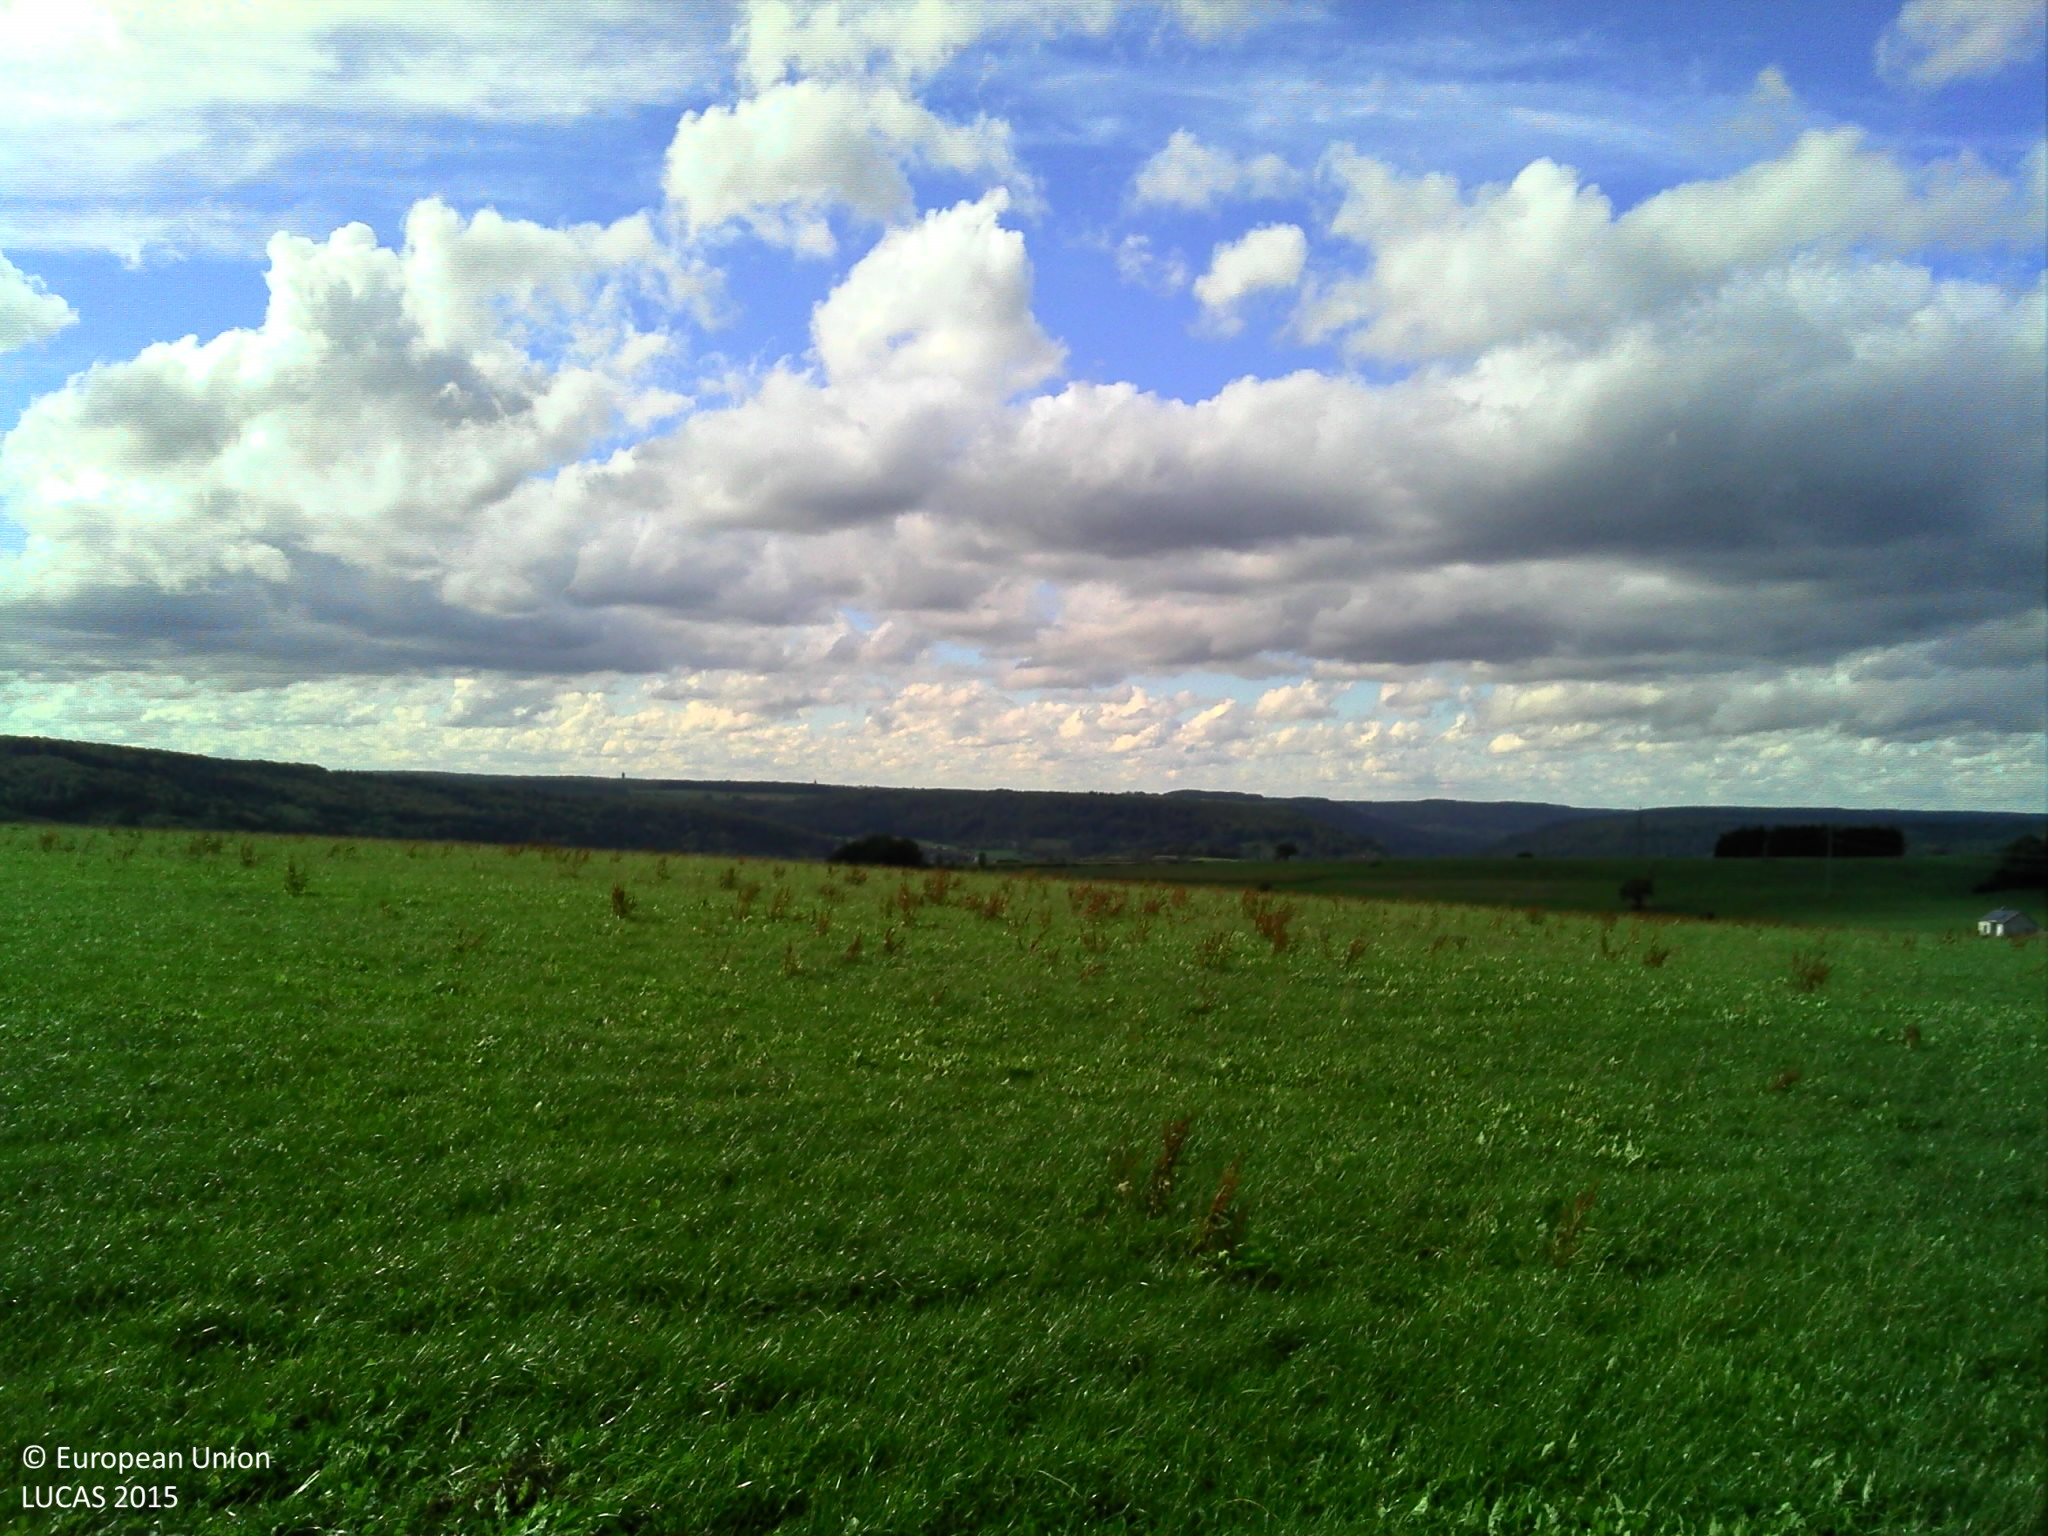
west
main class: Grassland
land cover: Grassland without tree/shrub cover
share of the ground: > 75 %
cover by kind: herbaceous plants 100 %
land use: Agriculture (excluding fallow land and kitchen gardens)
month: September
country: LU
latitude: 49.7872
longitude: 6.4578
